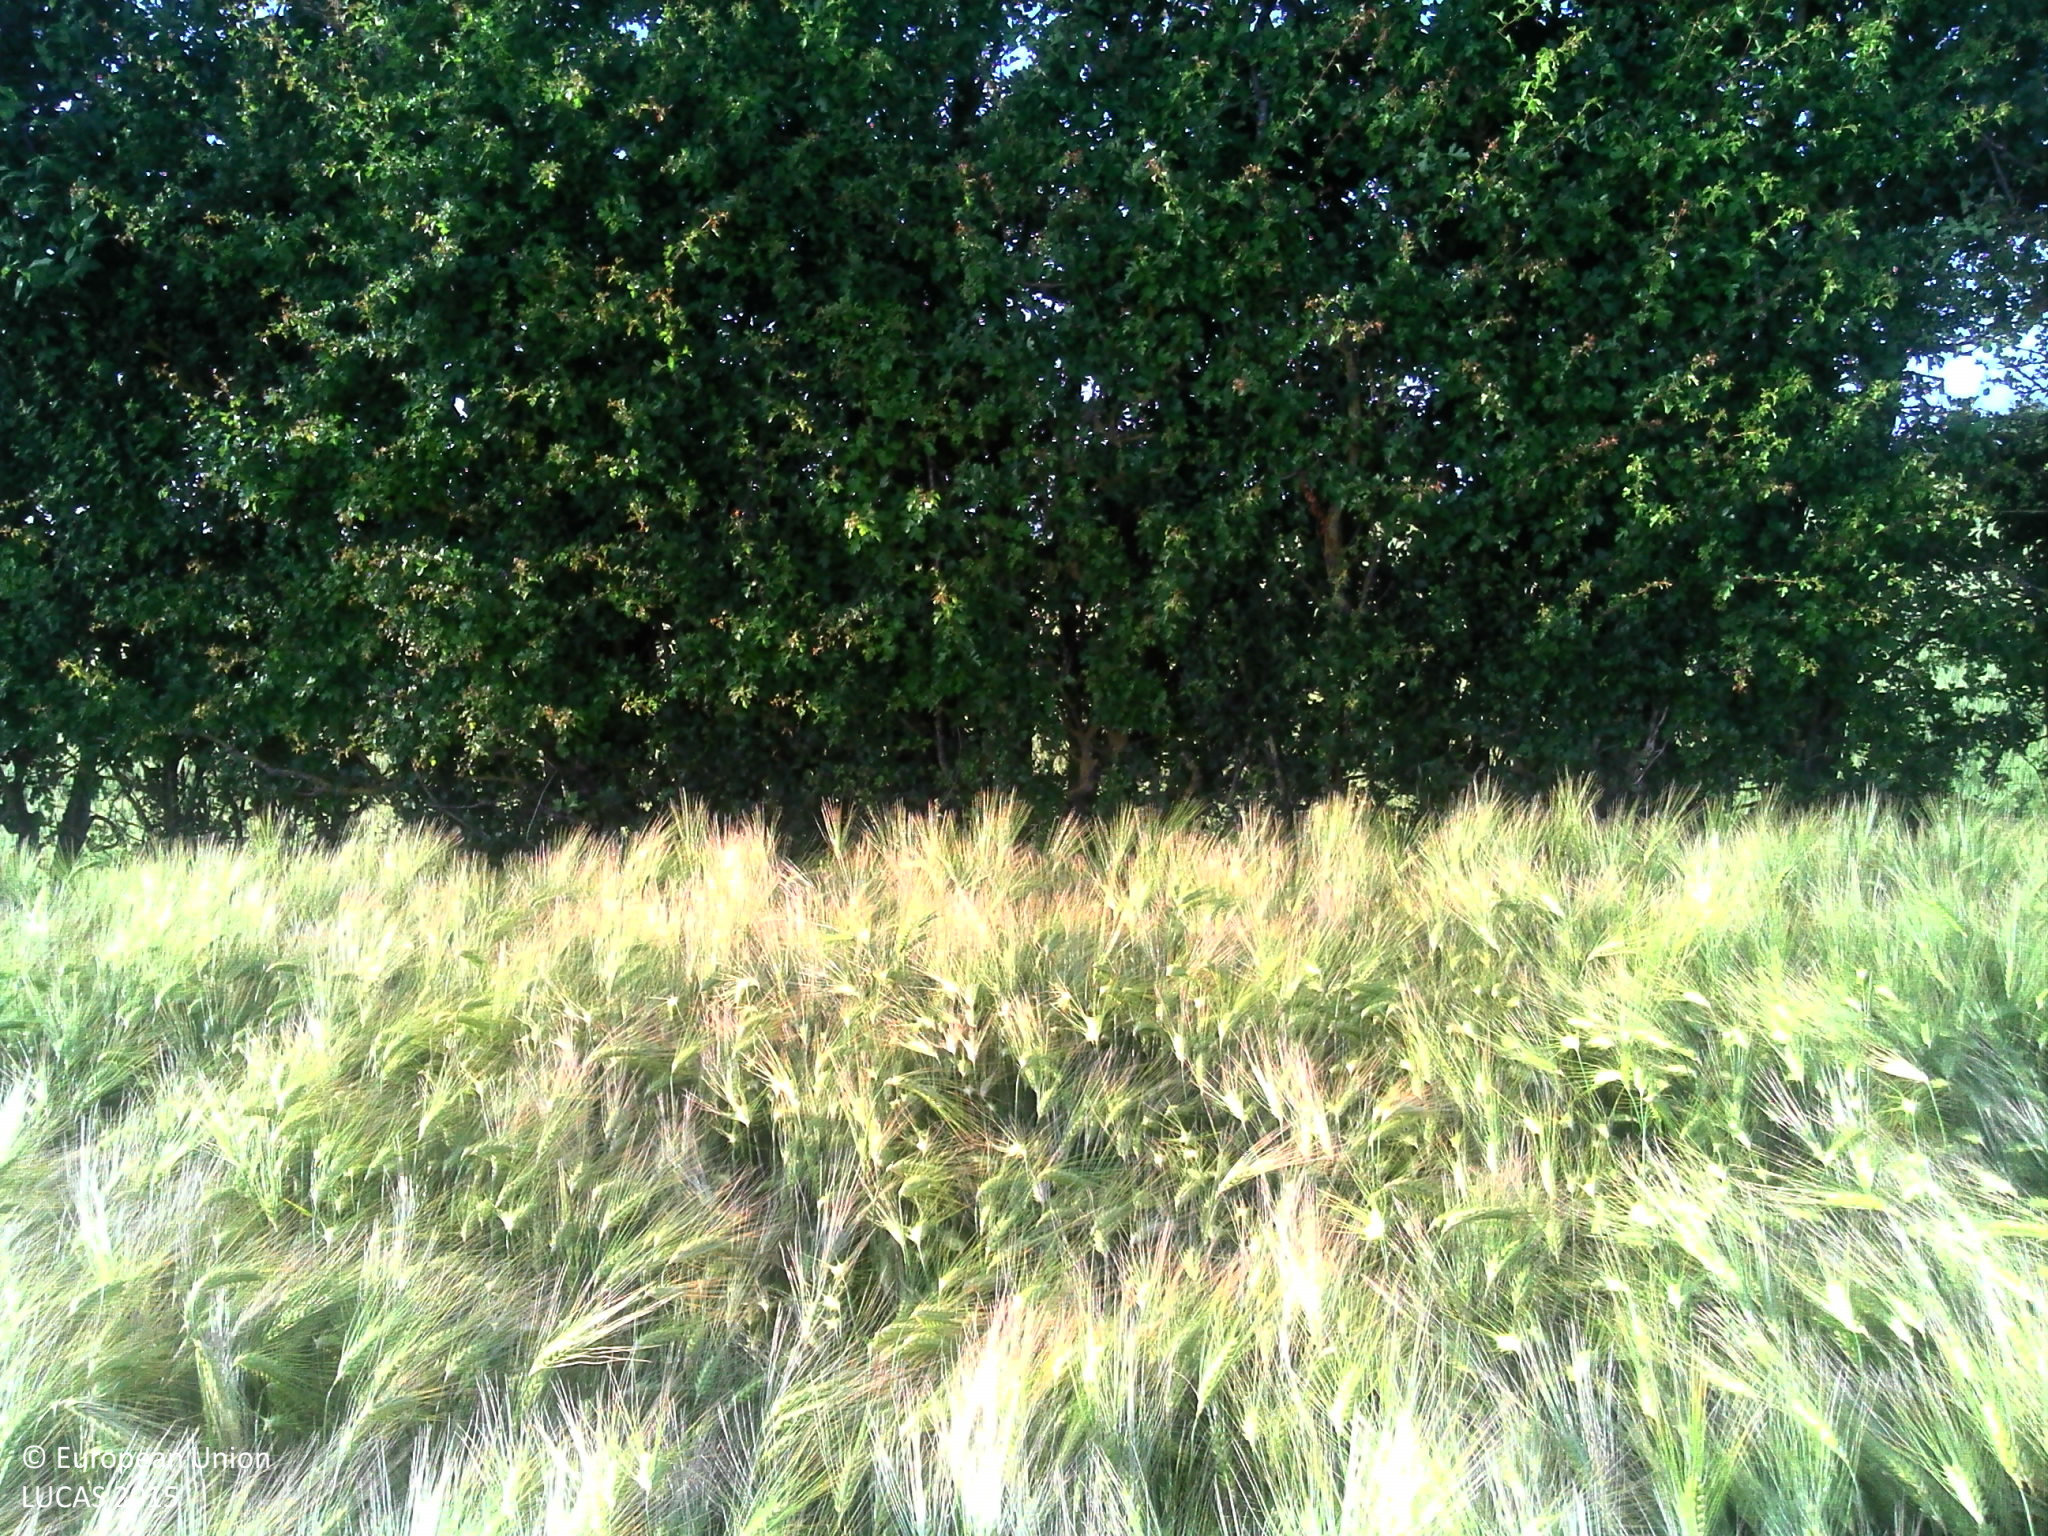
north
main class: Cropland
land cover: Barley
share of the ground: > 75 %
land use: Agriculture (excluding fallow land and kitchen gardens)
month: June
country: FR
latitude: 48.7897
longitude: 0.0749
